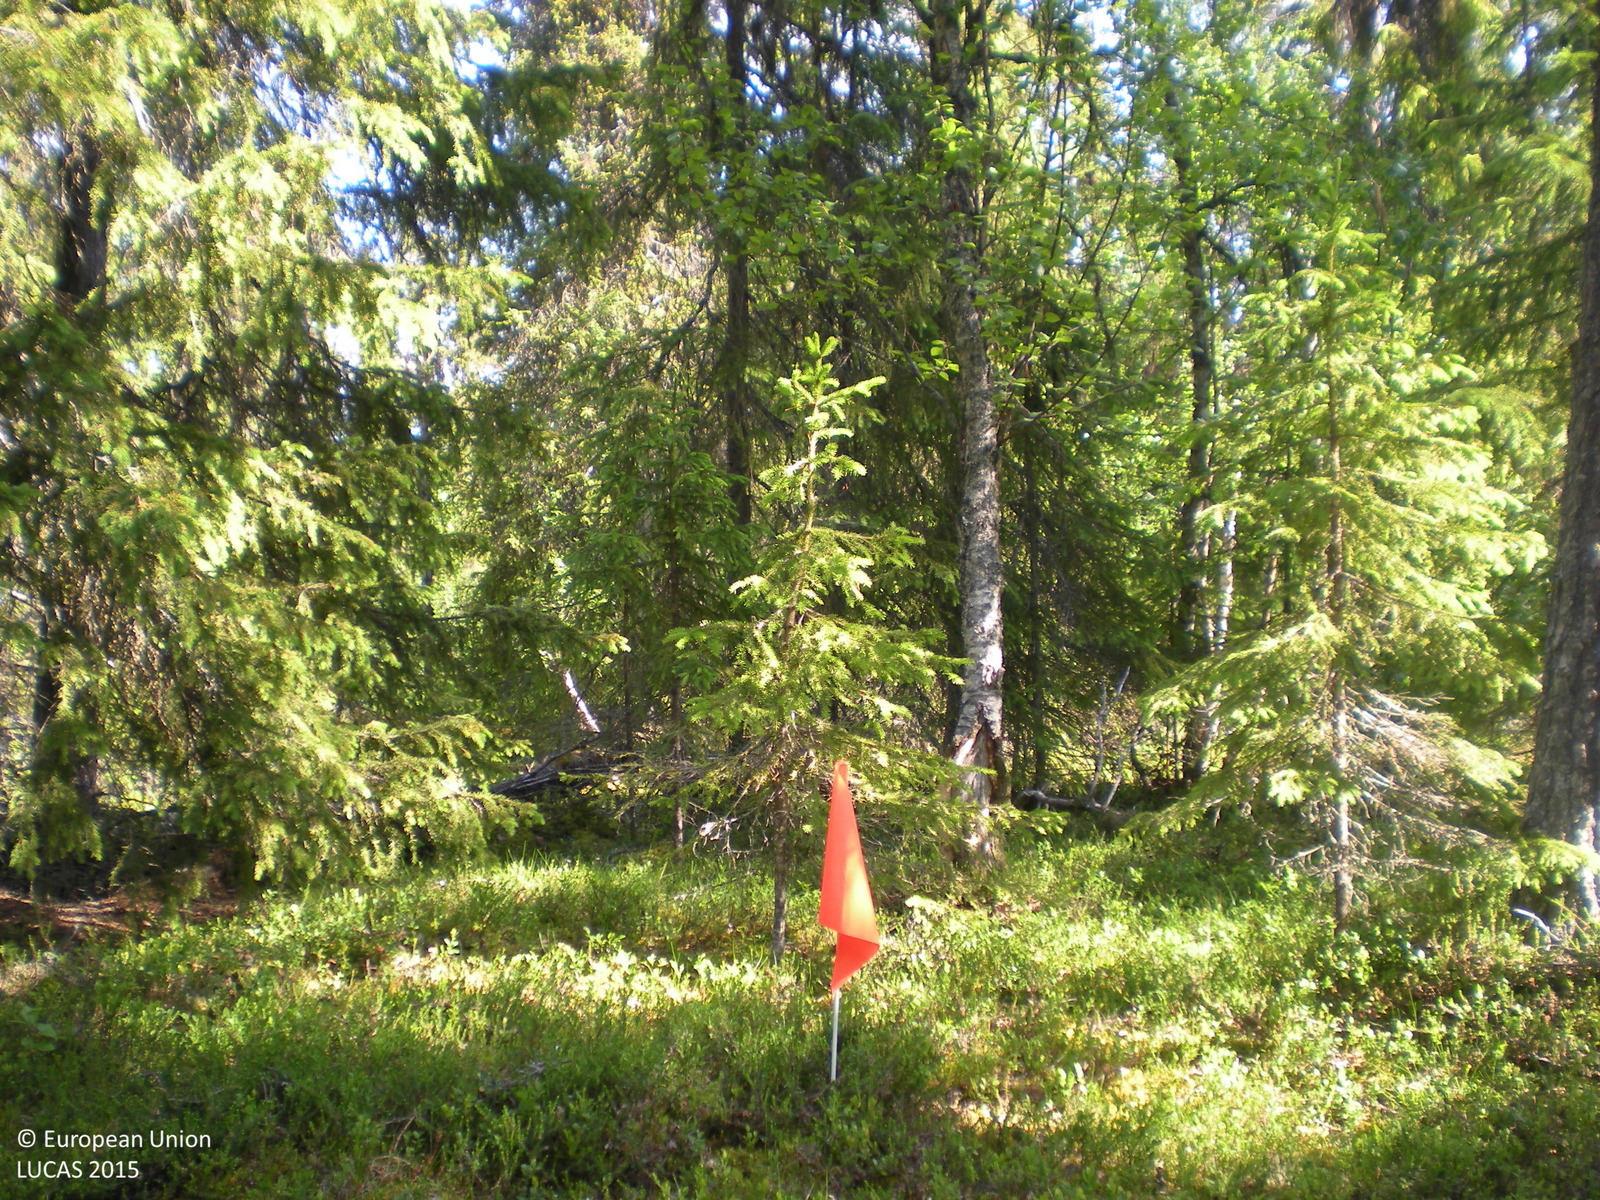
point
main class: Woodland
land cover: Spruce dominated mixed woodland
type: boreal forest
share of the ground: 50 - 75 %
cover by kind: coniferous forest trees 55 %, broadleaved forest trees 20 %, shrubs 10 %, lichens and mosses 10 %, herbaceous plants 5 %
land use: Semi-natural and natural areas not in use
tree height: > 5 m
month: July
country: SE
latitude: 65.6466
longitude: 16.4154
